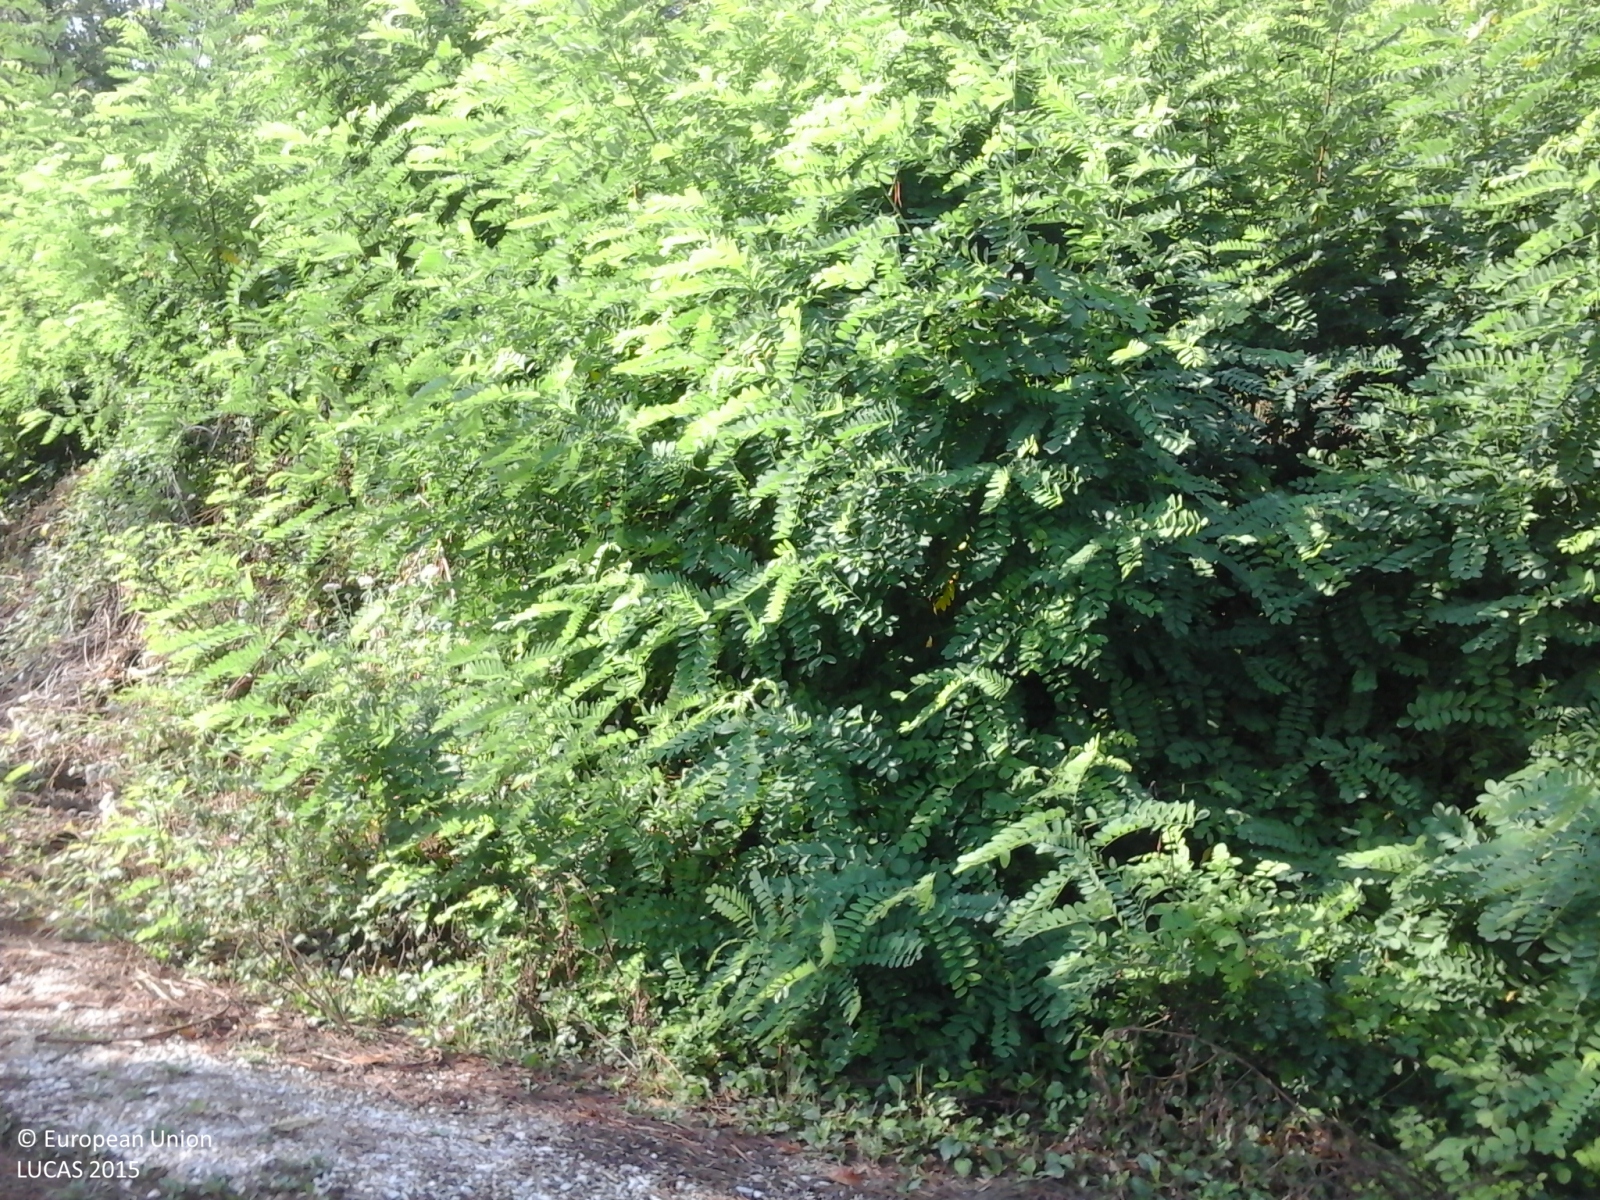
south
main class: Woodland
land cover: Other mixed woodland
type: thermophilous deciduous forest
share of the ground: > 75 %
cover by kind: broadleaved forest trees 60 %, coniferous forest trees 30 %, shrubs 10 %
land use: Forestry
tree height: > 5 m
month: August
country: IT
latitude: 43.8990
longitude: 10.3353
